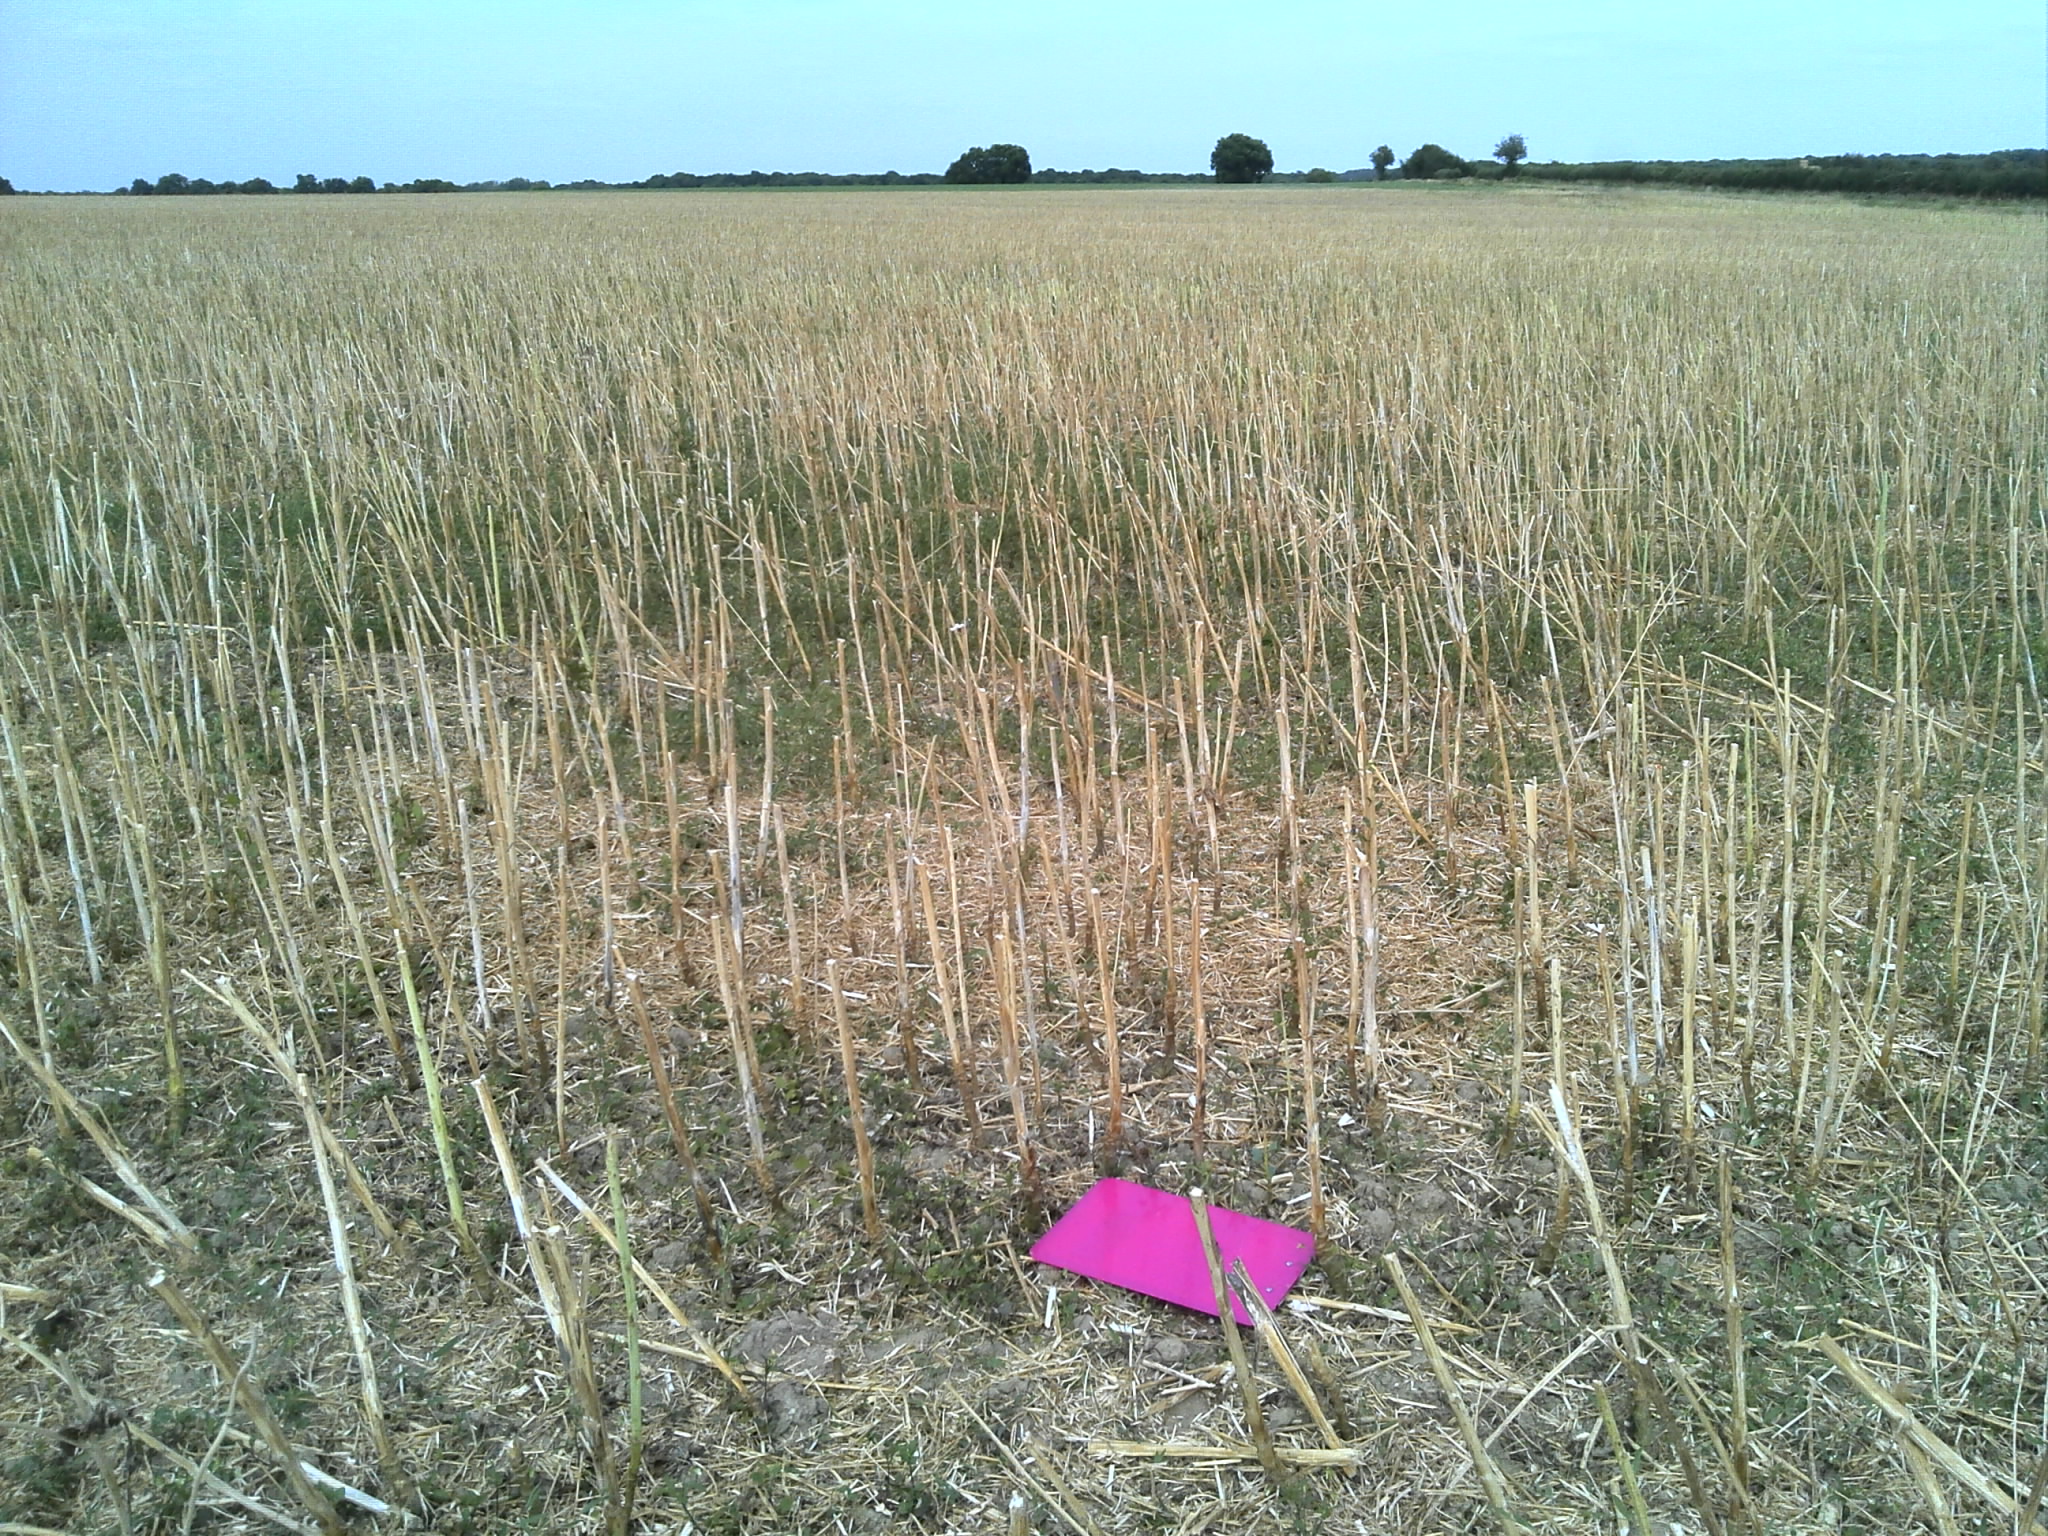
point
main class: Cropland
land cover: Rape and turnip rape
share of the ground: < 10 %
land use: Agriculture (excluding fallow land and kitchen gardens)
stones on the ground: < 10 %
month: July
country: FR
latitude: 46.6984
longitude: 1.4751
